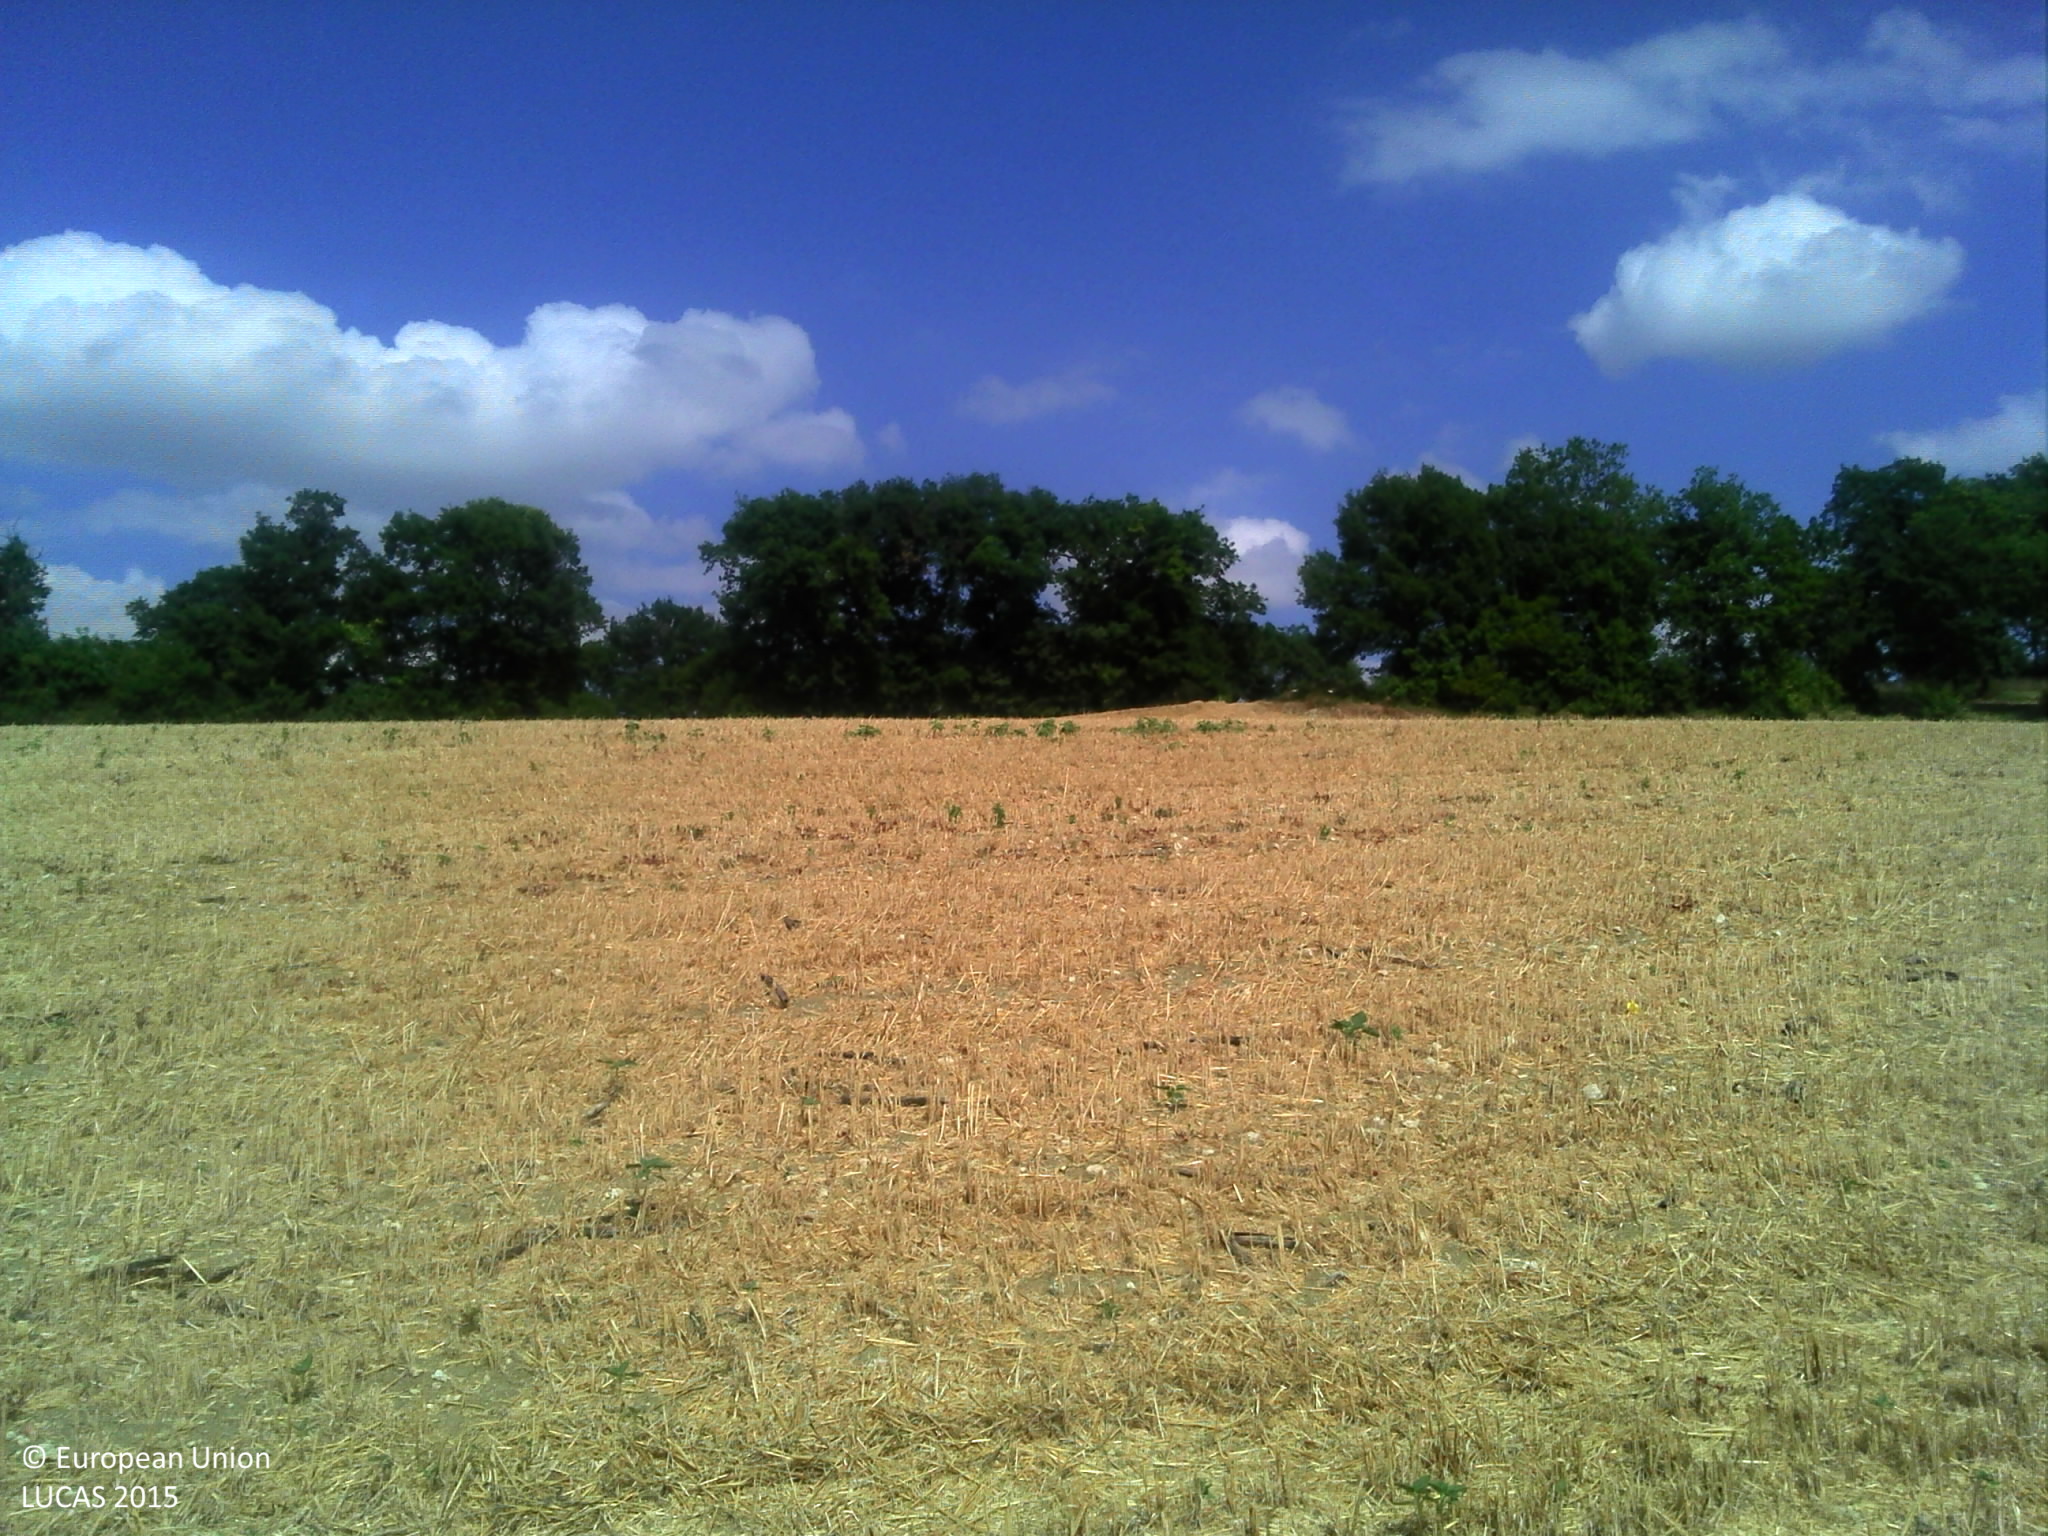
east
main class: Cropland
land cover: Durum wheat
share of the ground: > 75 %
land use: Agriculture (excluding fallow land and kitchen gardens)
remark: Harvested field
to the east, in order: Durum wheat; Broadleaved woodland; Grassland without tree/shrub cover; Tracks; Grassland without tree/shrub cover; Electric lines; Tracks; Grass margins; Broadleaved woodland; Grassland with sparse tree/shrub cover; Grassland without tree/shrub cover; Broadleaved woodland
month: July
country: FR
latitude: 43.9805
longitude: 0.6335
